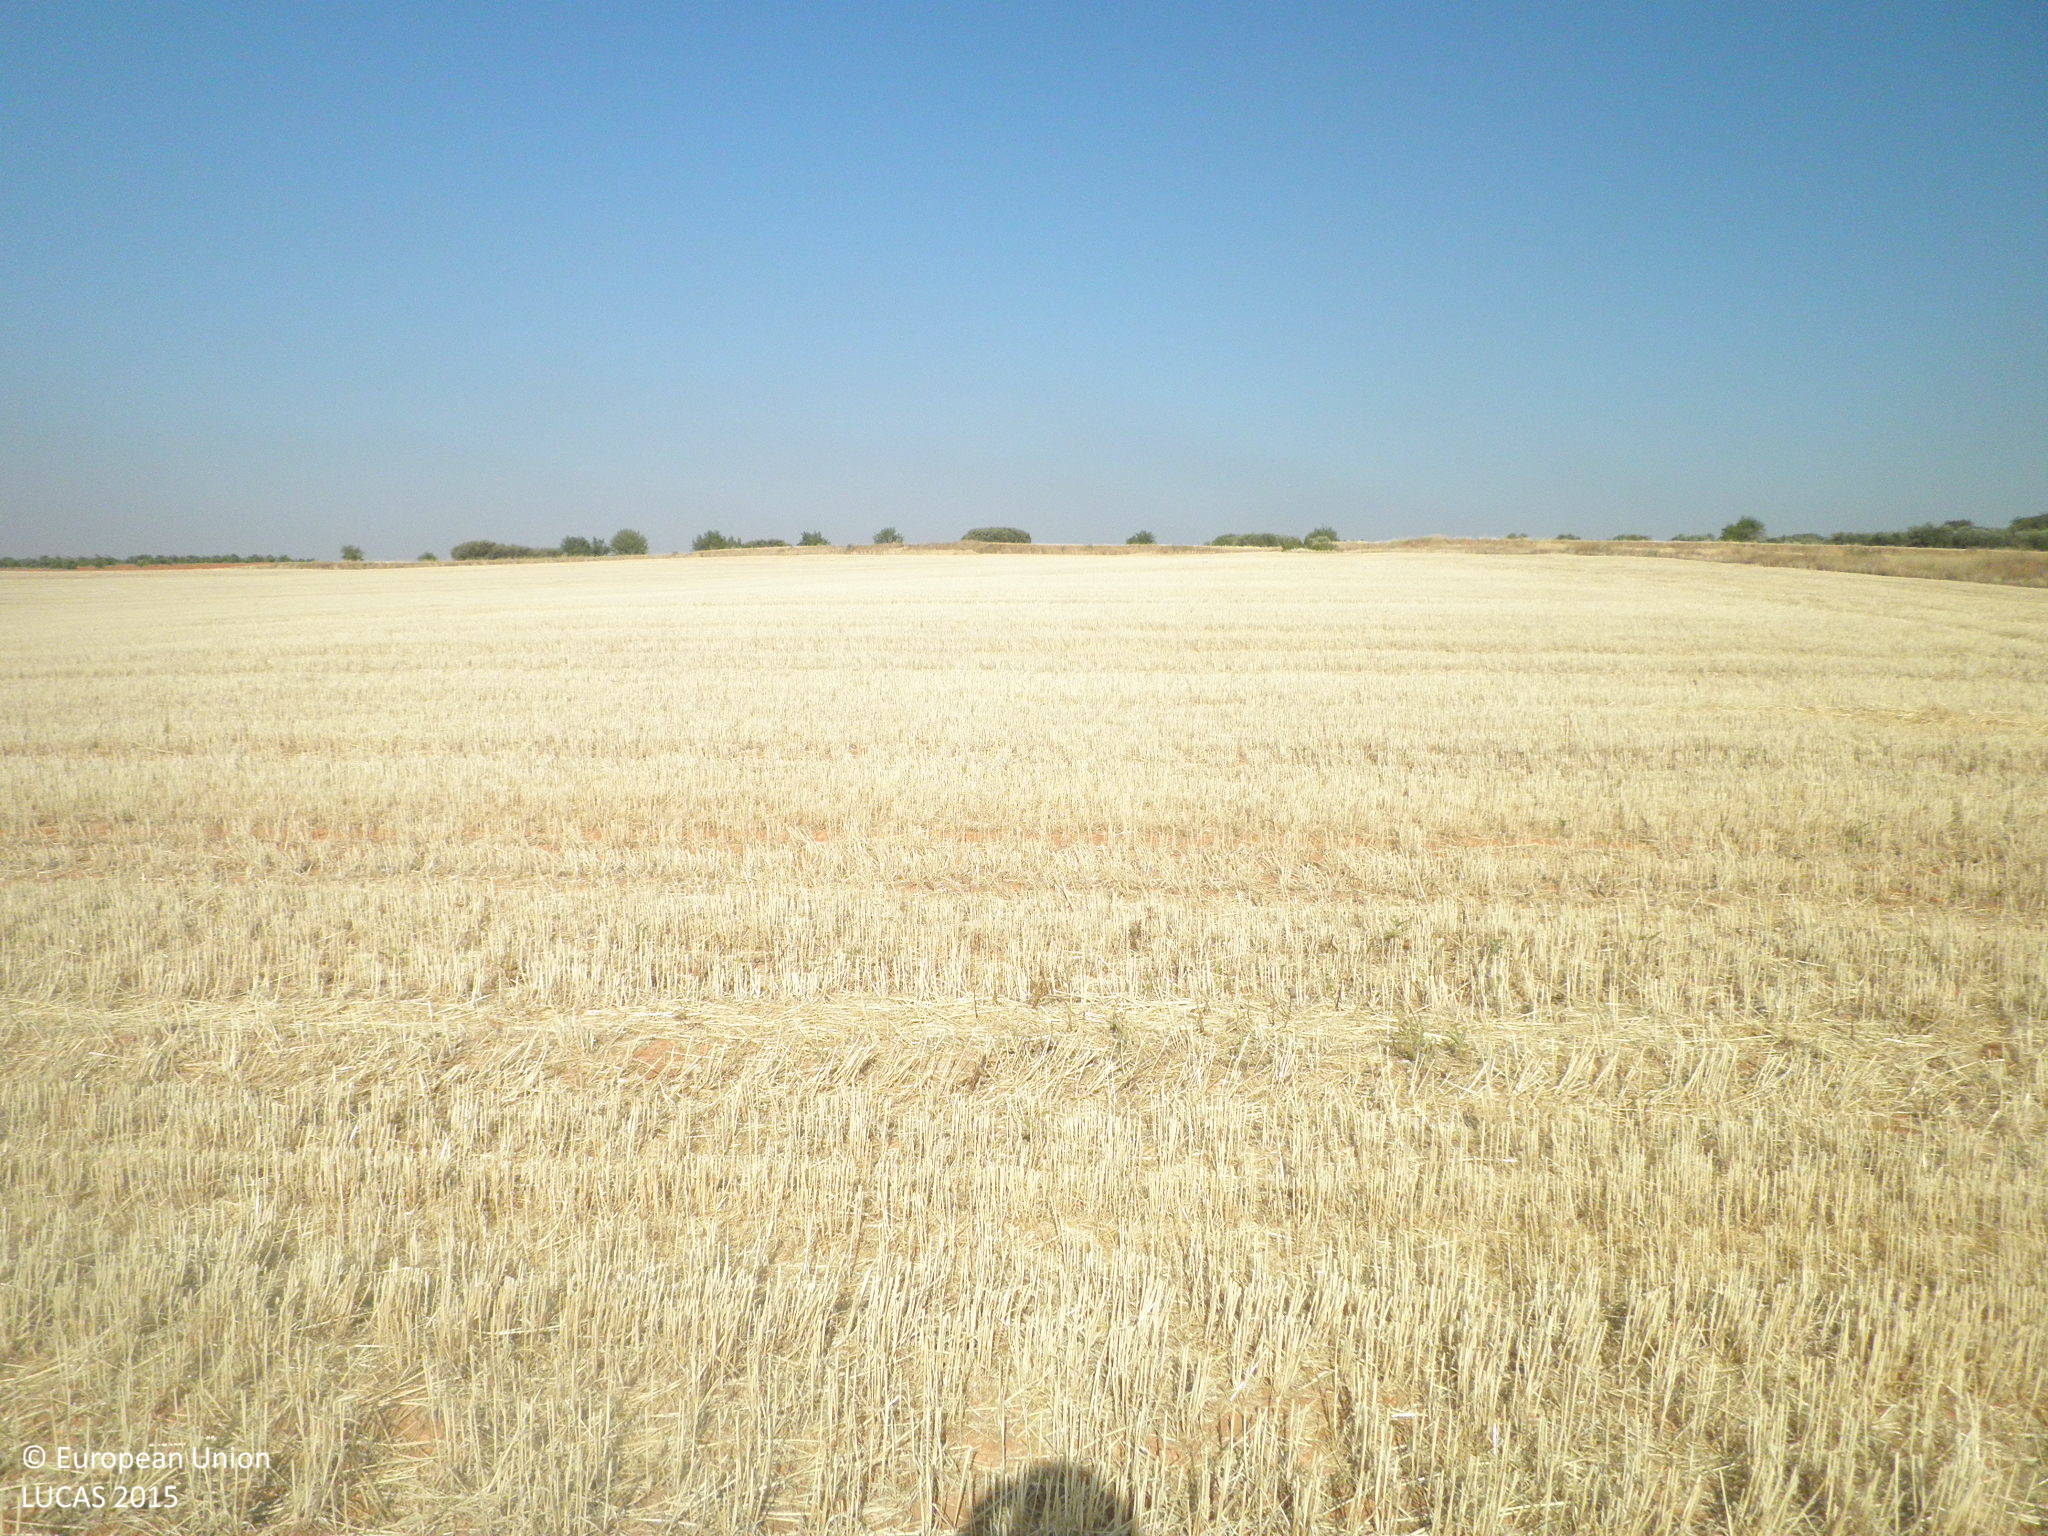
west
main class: Cropland
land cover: Barley
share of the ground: < 10 %
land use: Agriculture (excluding fallow land and kitchen gardens)
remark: Harvested field
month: July
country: ES
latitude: 39.6039
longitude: -1.8286
